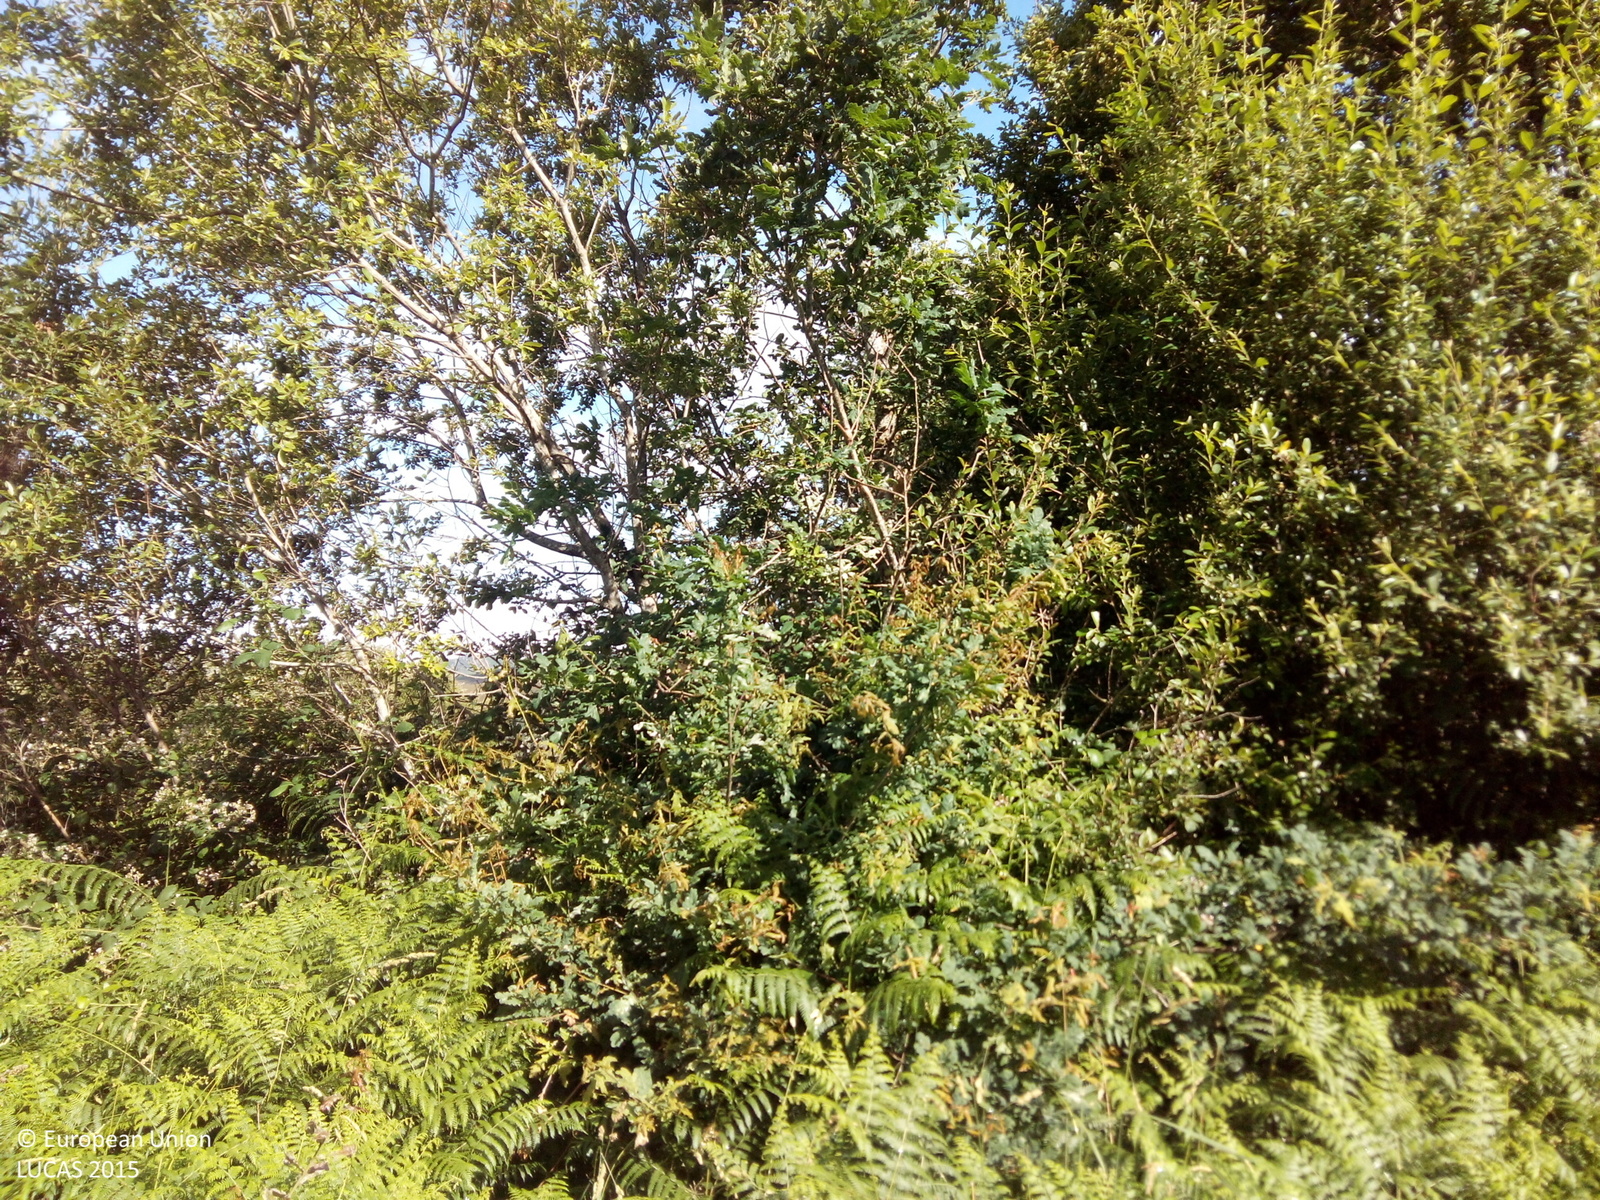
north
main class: Grassland
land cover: Grassland with sparse tree/shrub cover
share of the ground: > 75 %
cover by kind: herbaceous plants 95 %, coniferous forest trees 5 %
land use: Abandoned areas
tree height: < 5 m
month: July
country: ES
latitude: 42.3222
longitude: -8.2781
